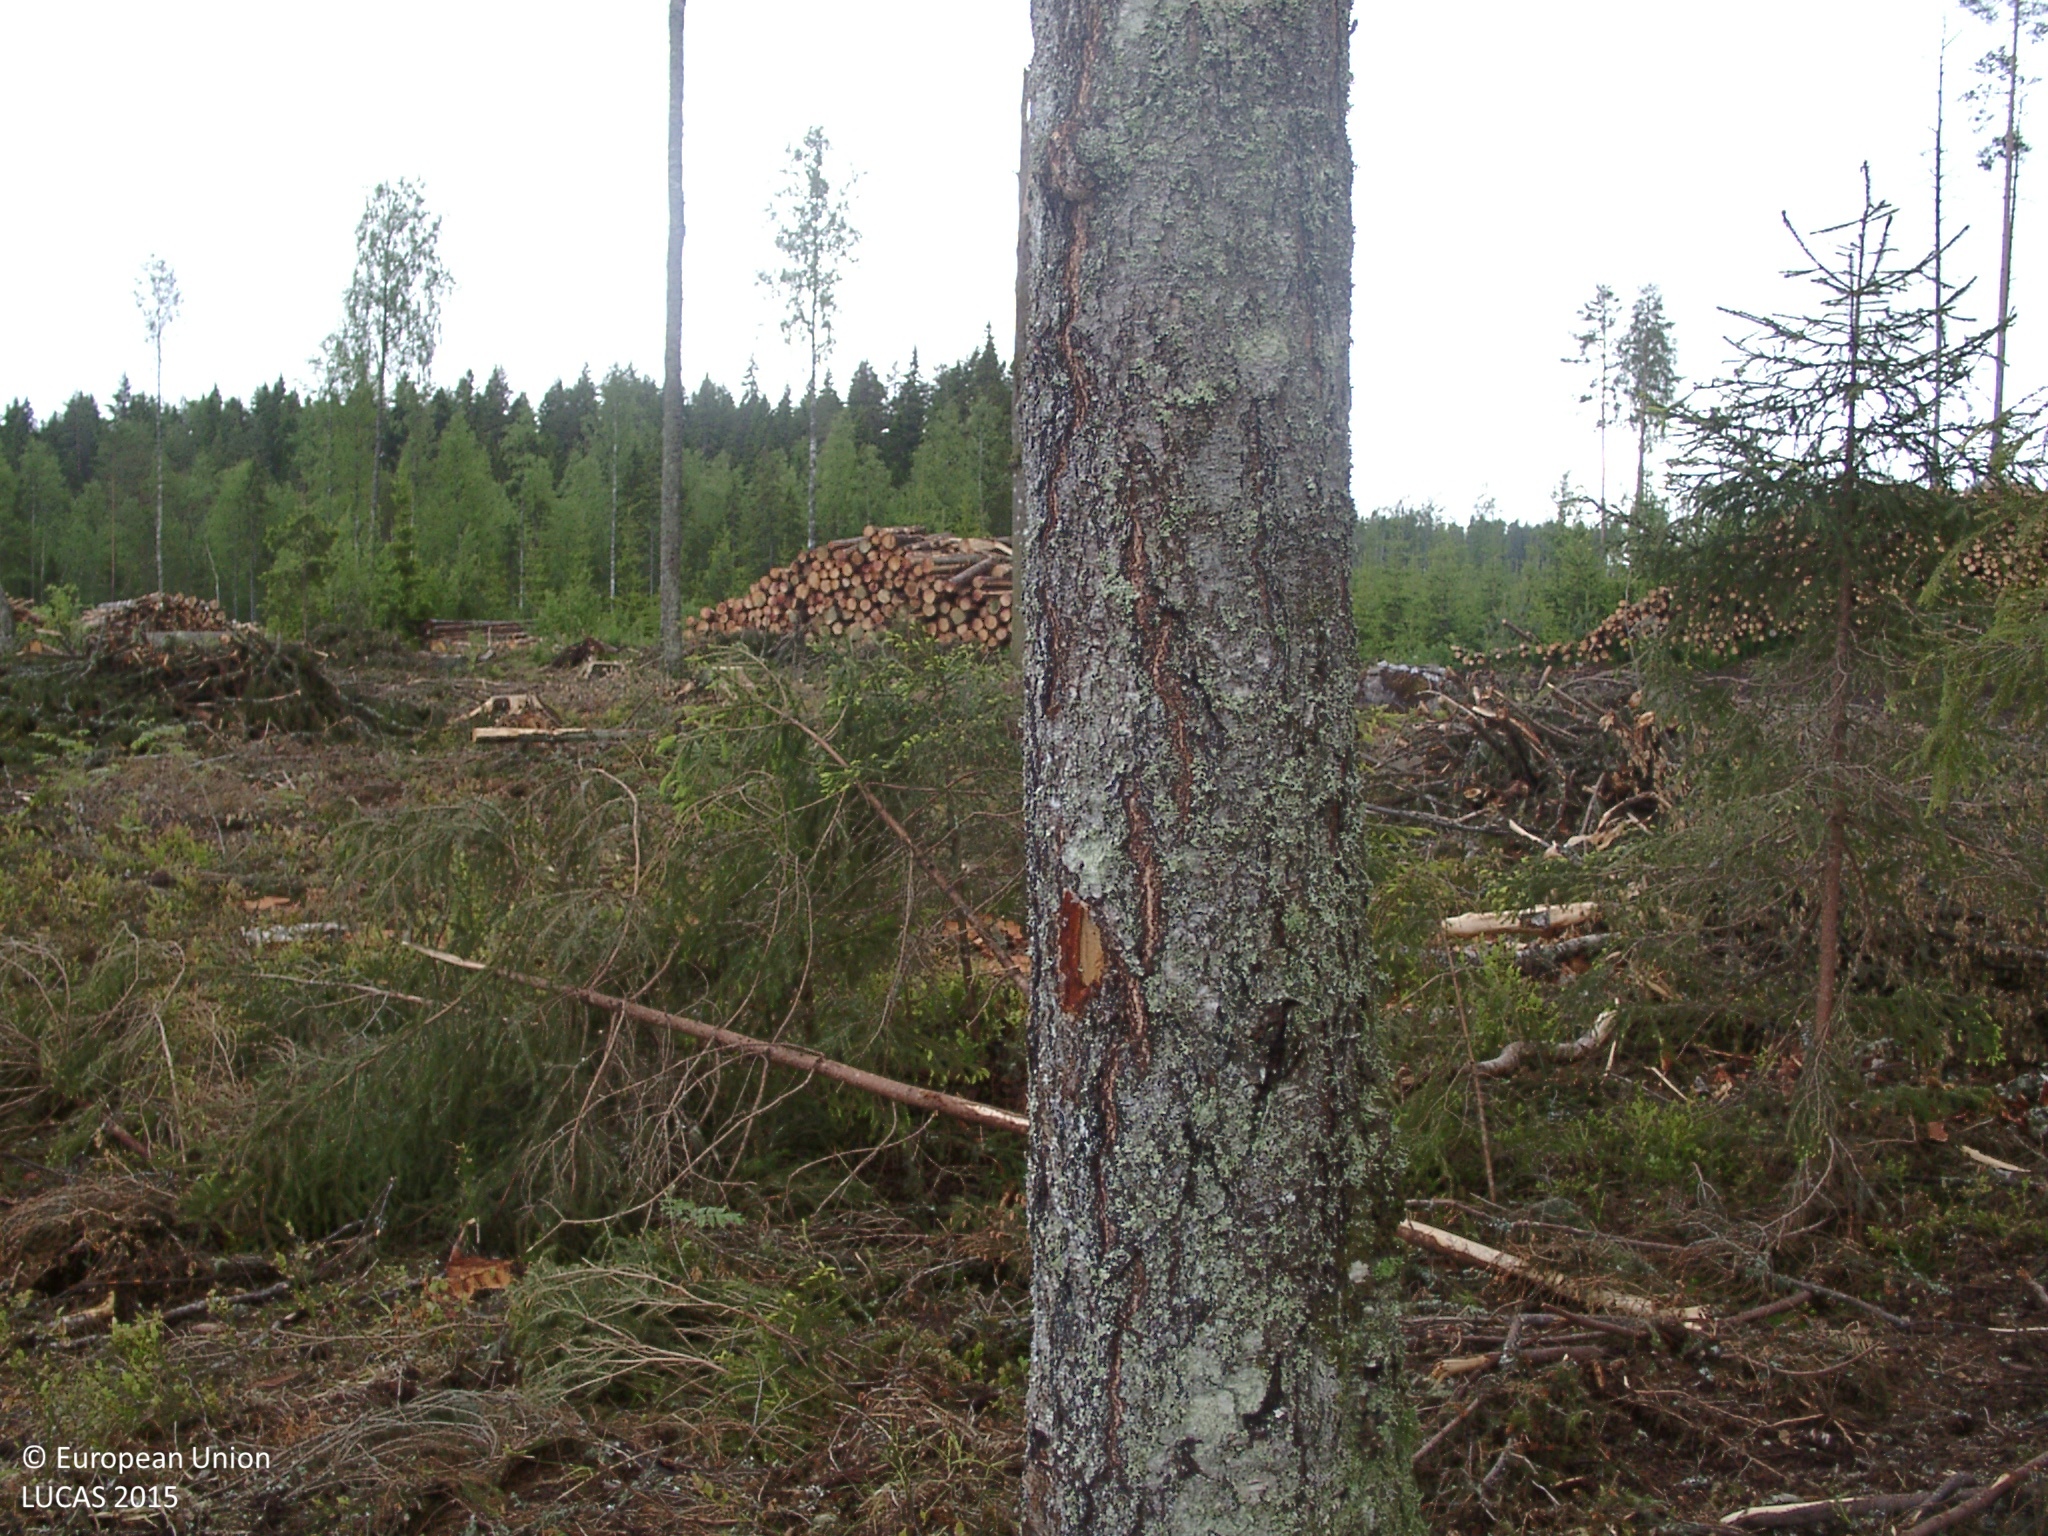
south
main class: Shrubland
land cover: Shrubland with sparse tree cover
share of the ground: 10 - 25 %
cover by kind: unconsolidated bare surface 50 %, shrubs 10 %, broadleaved forest trees 5 %
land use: Forestry
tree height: > 5 m
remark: Clear cut
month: June
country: FI
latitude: 61.5792
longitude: 24.8144
